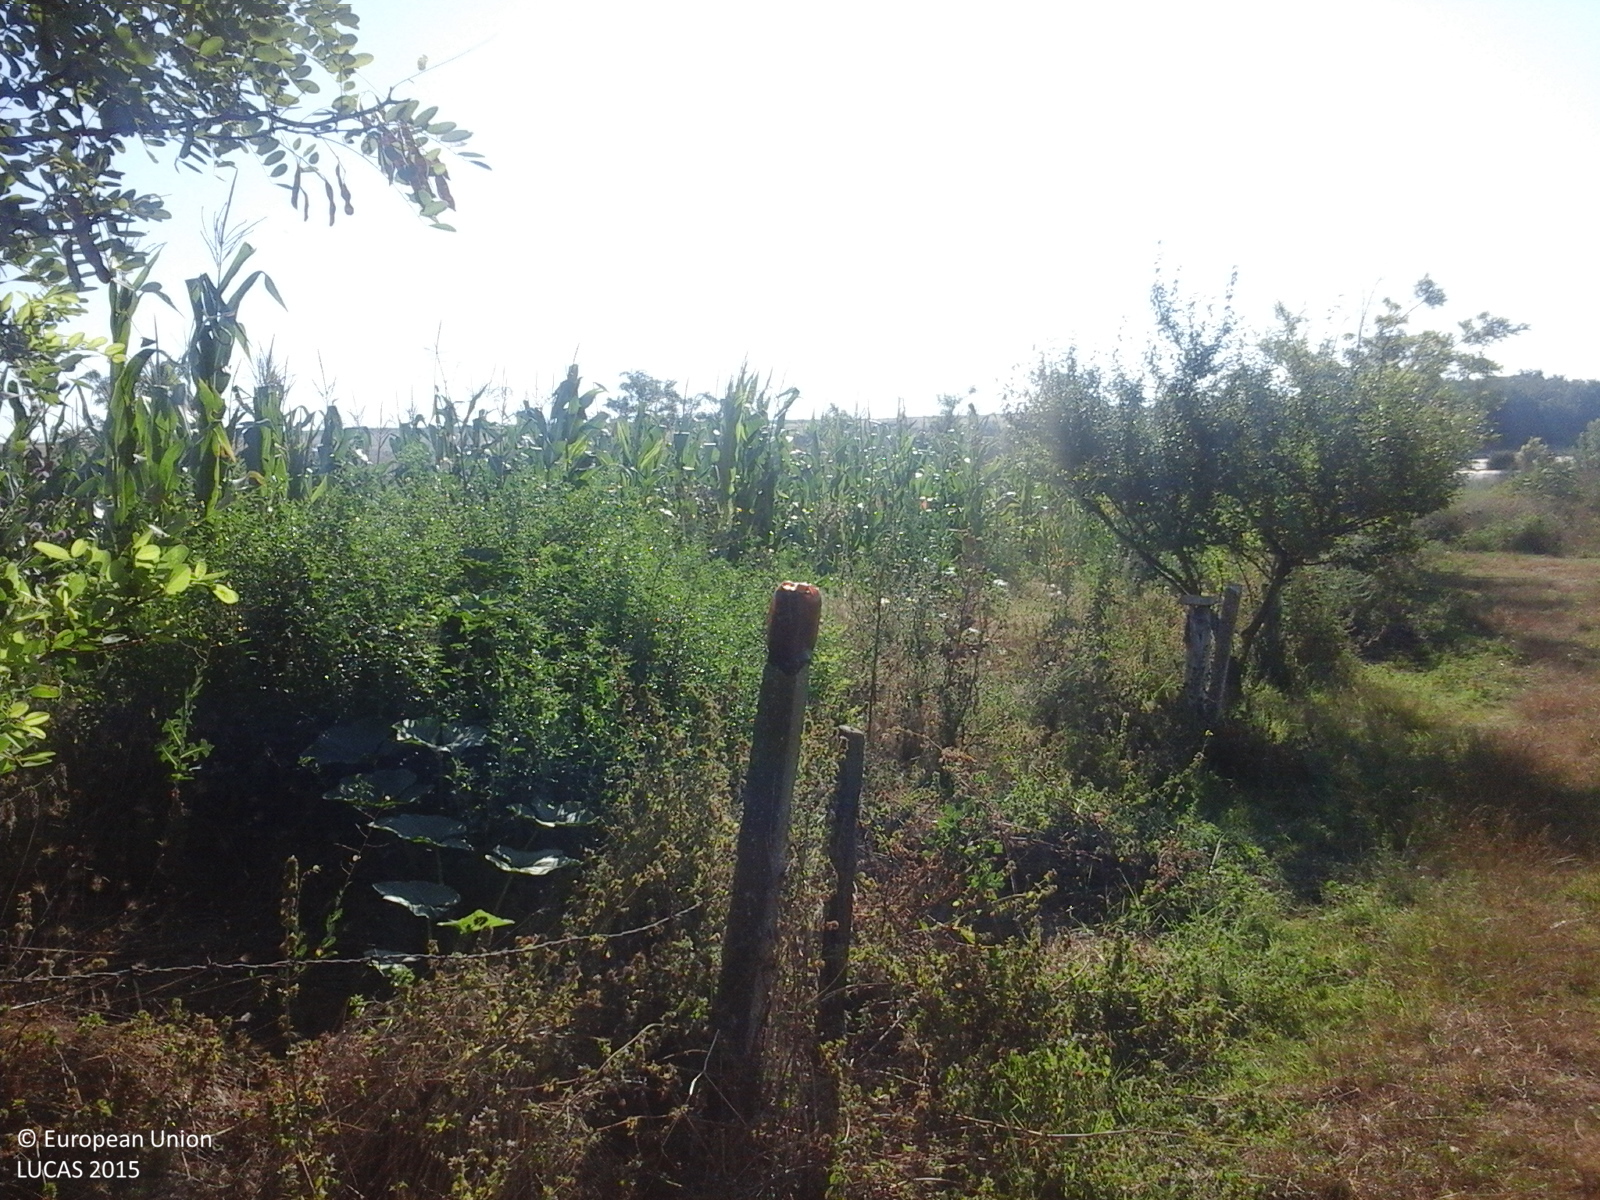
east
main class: Cropland
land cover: Maize
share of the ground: > 75 %
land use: Agriculture (excluding fallow land and kitchen gardens)
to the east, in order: Tracks; Abandoned hedges; Fences; Shruby margins; Maize; Shruby margins; Abandoned hedges; Fences; Spontaneously vegetated surfaces; Tracks; Lucerne; Grassland without tree/shrub cover; Rivers and streams; Grassland without tree/shrub cover; Tracks; Grassland without tree/shrub cover; Fences; Grassland without tree/shrub cover
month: August
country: RO
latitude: 44.6377
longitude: 28.1280
